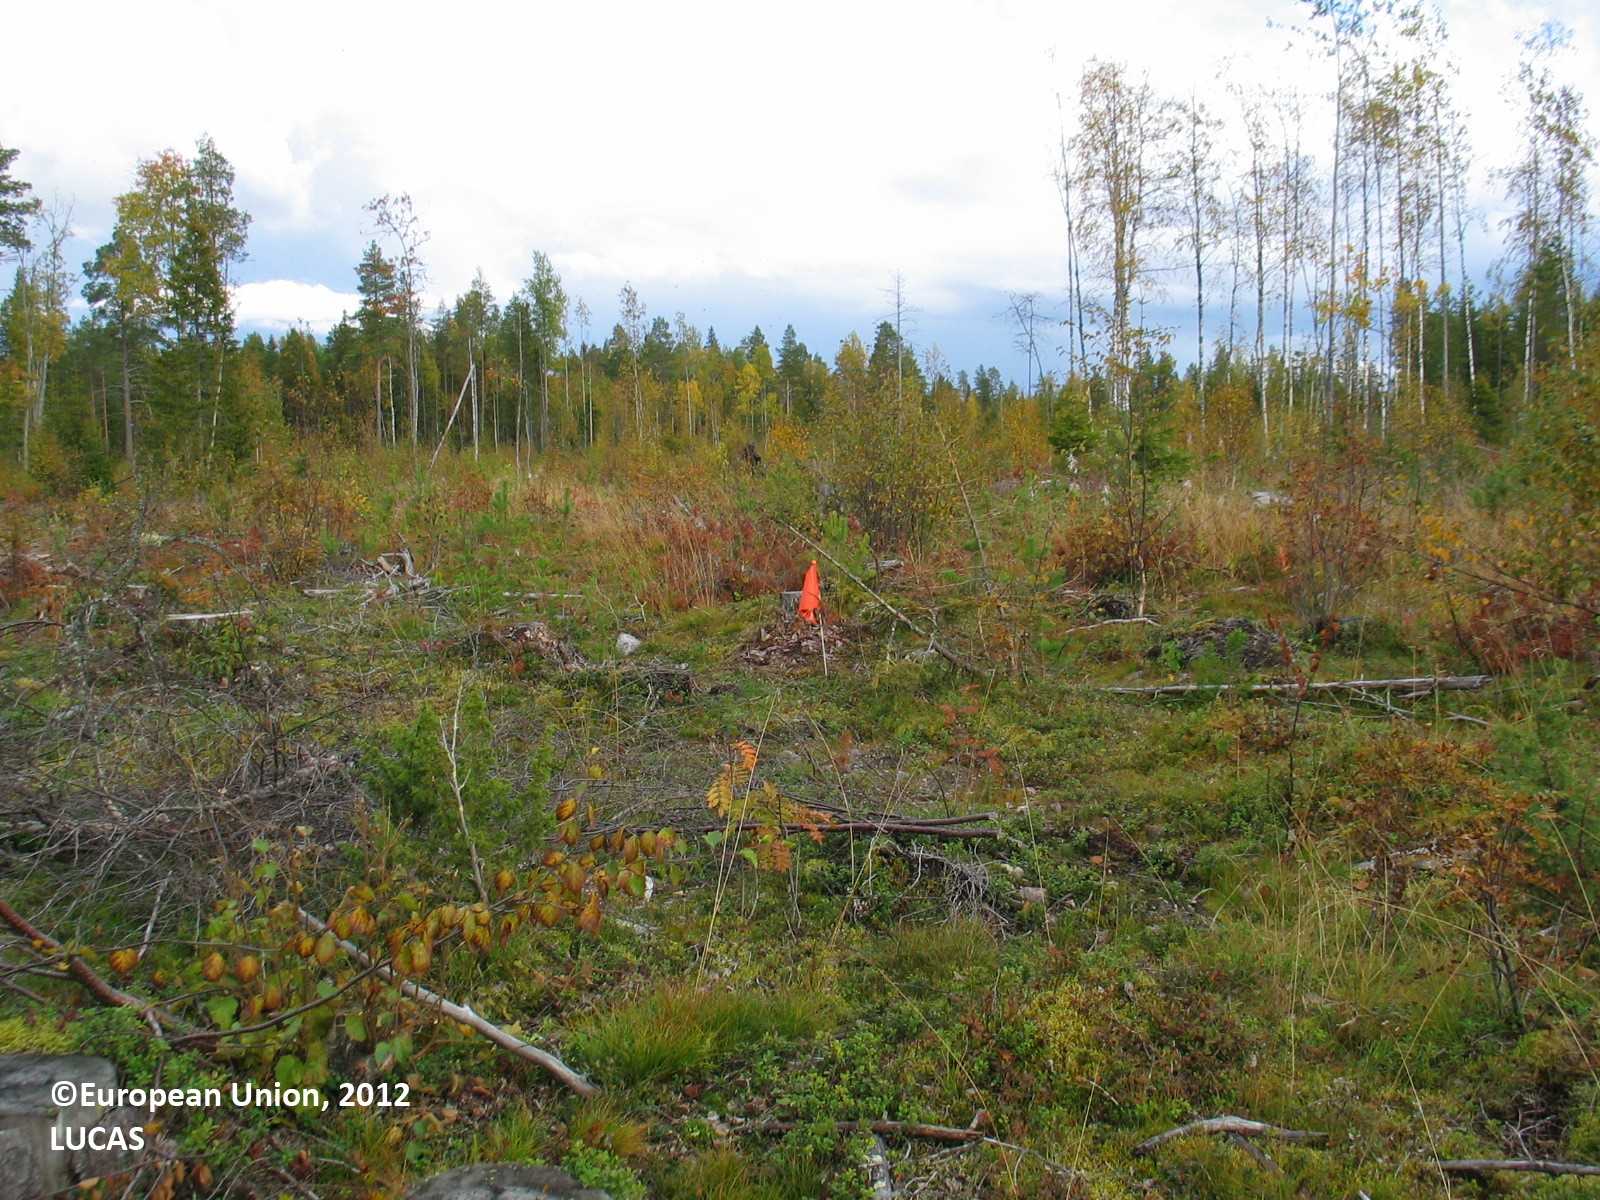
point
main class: Woodland
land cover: Other mixed woodland
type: boreal forest
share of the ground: 25 - 50 %
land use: Forestry
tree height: < 5 m
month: September
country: FI
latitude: 65.5617
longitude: 25.6110
